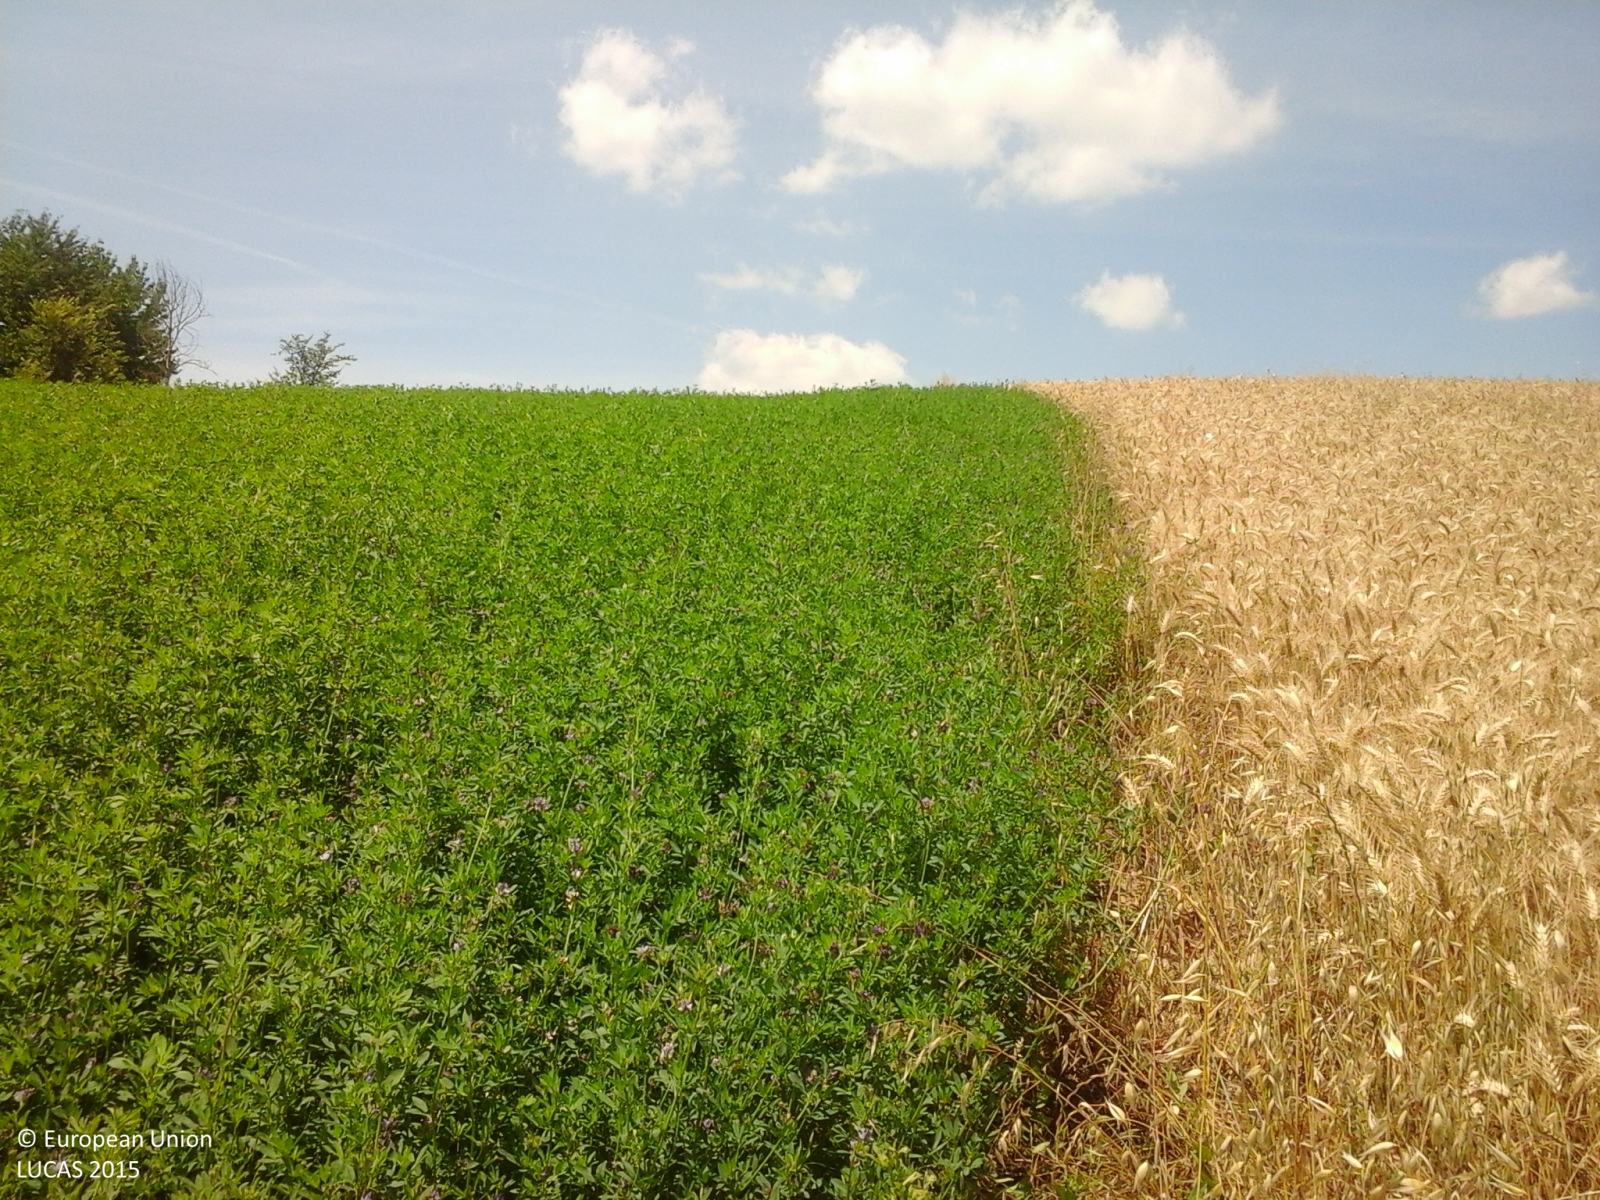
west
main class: Cropland
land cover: Common wheat
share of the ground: > 75 %
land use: Agriculture (excluding fallow land and kitchen gardens)
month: June
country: IT
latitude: 45.0042
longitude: 8.3158
